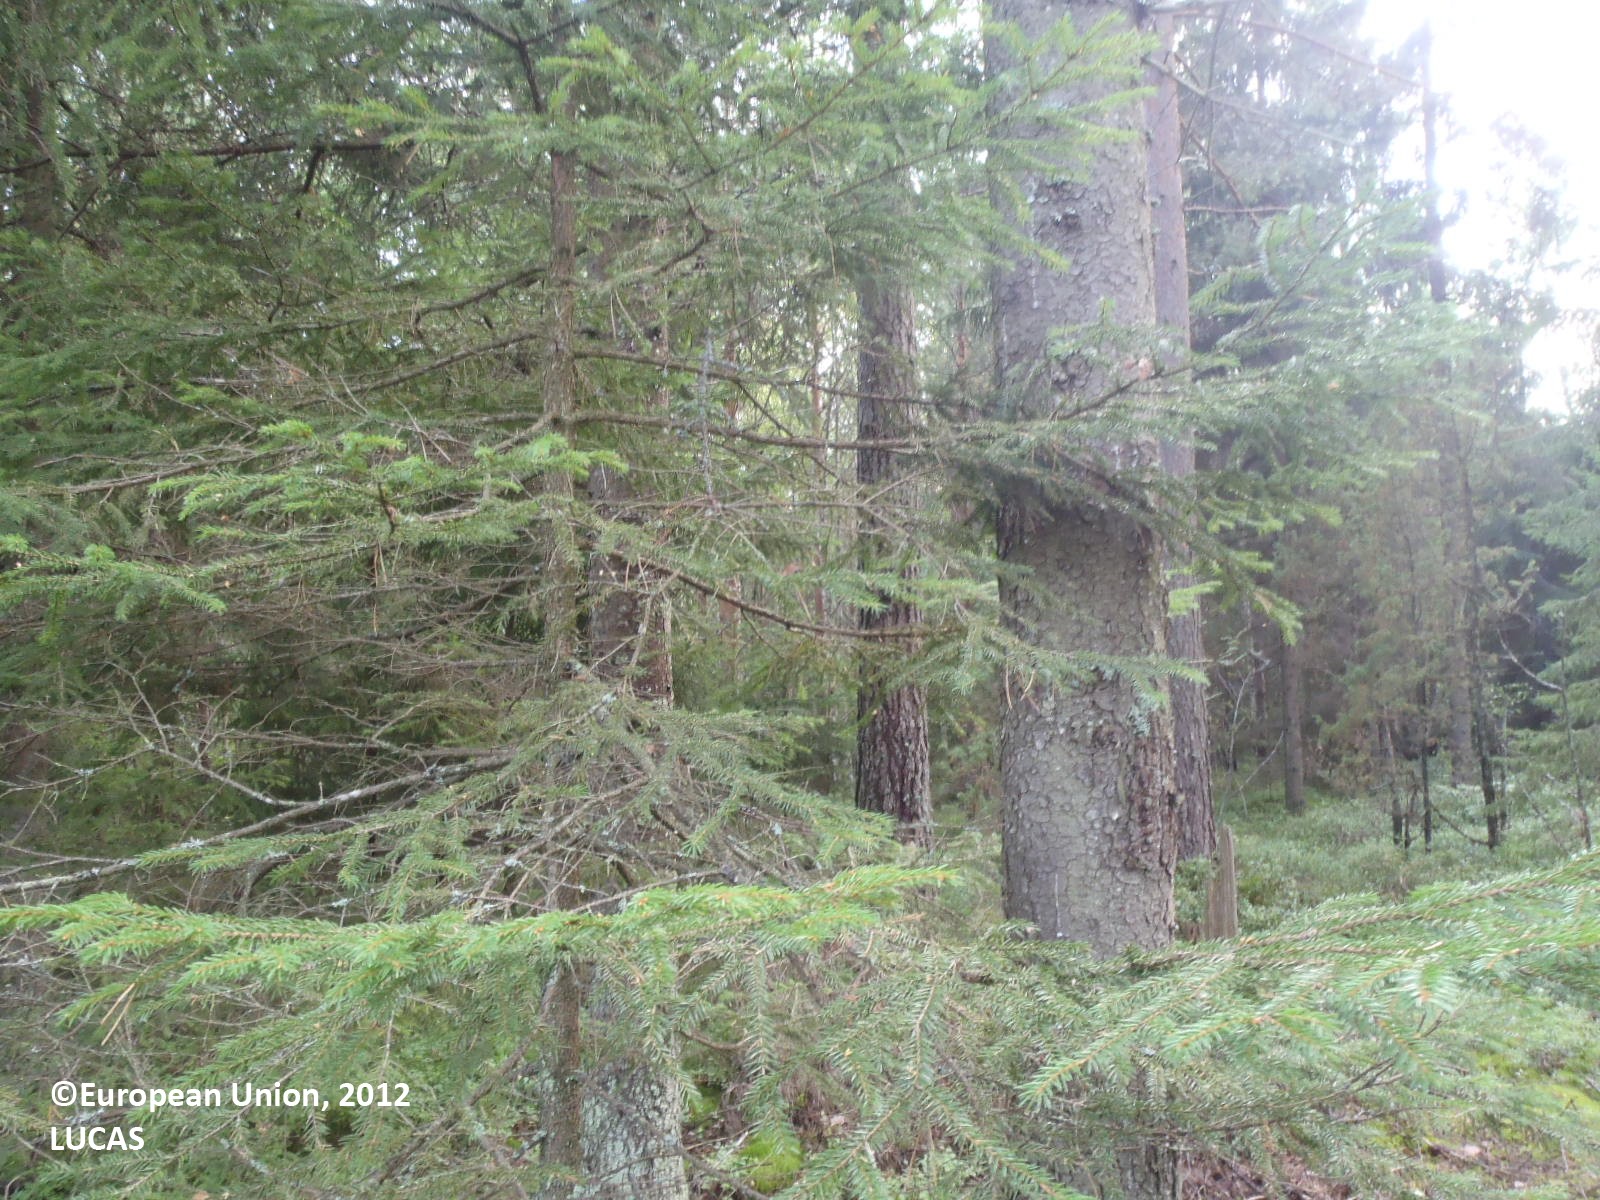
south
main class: Woodland
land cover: Pine dominated coniferous woodland
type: boreal forest
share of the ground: > 75 %
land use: Forestry
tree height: > 5 m
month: August
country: FI
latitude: 60.5738
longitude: 22.6812
